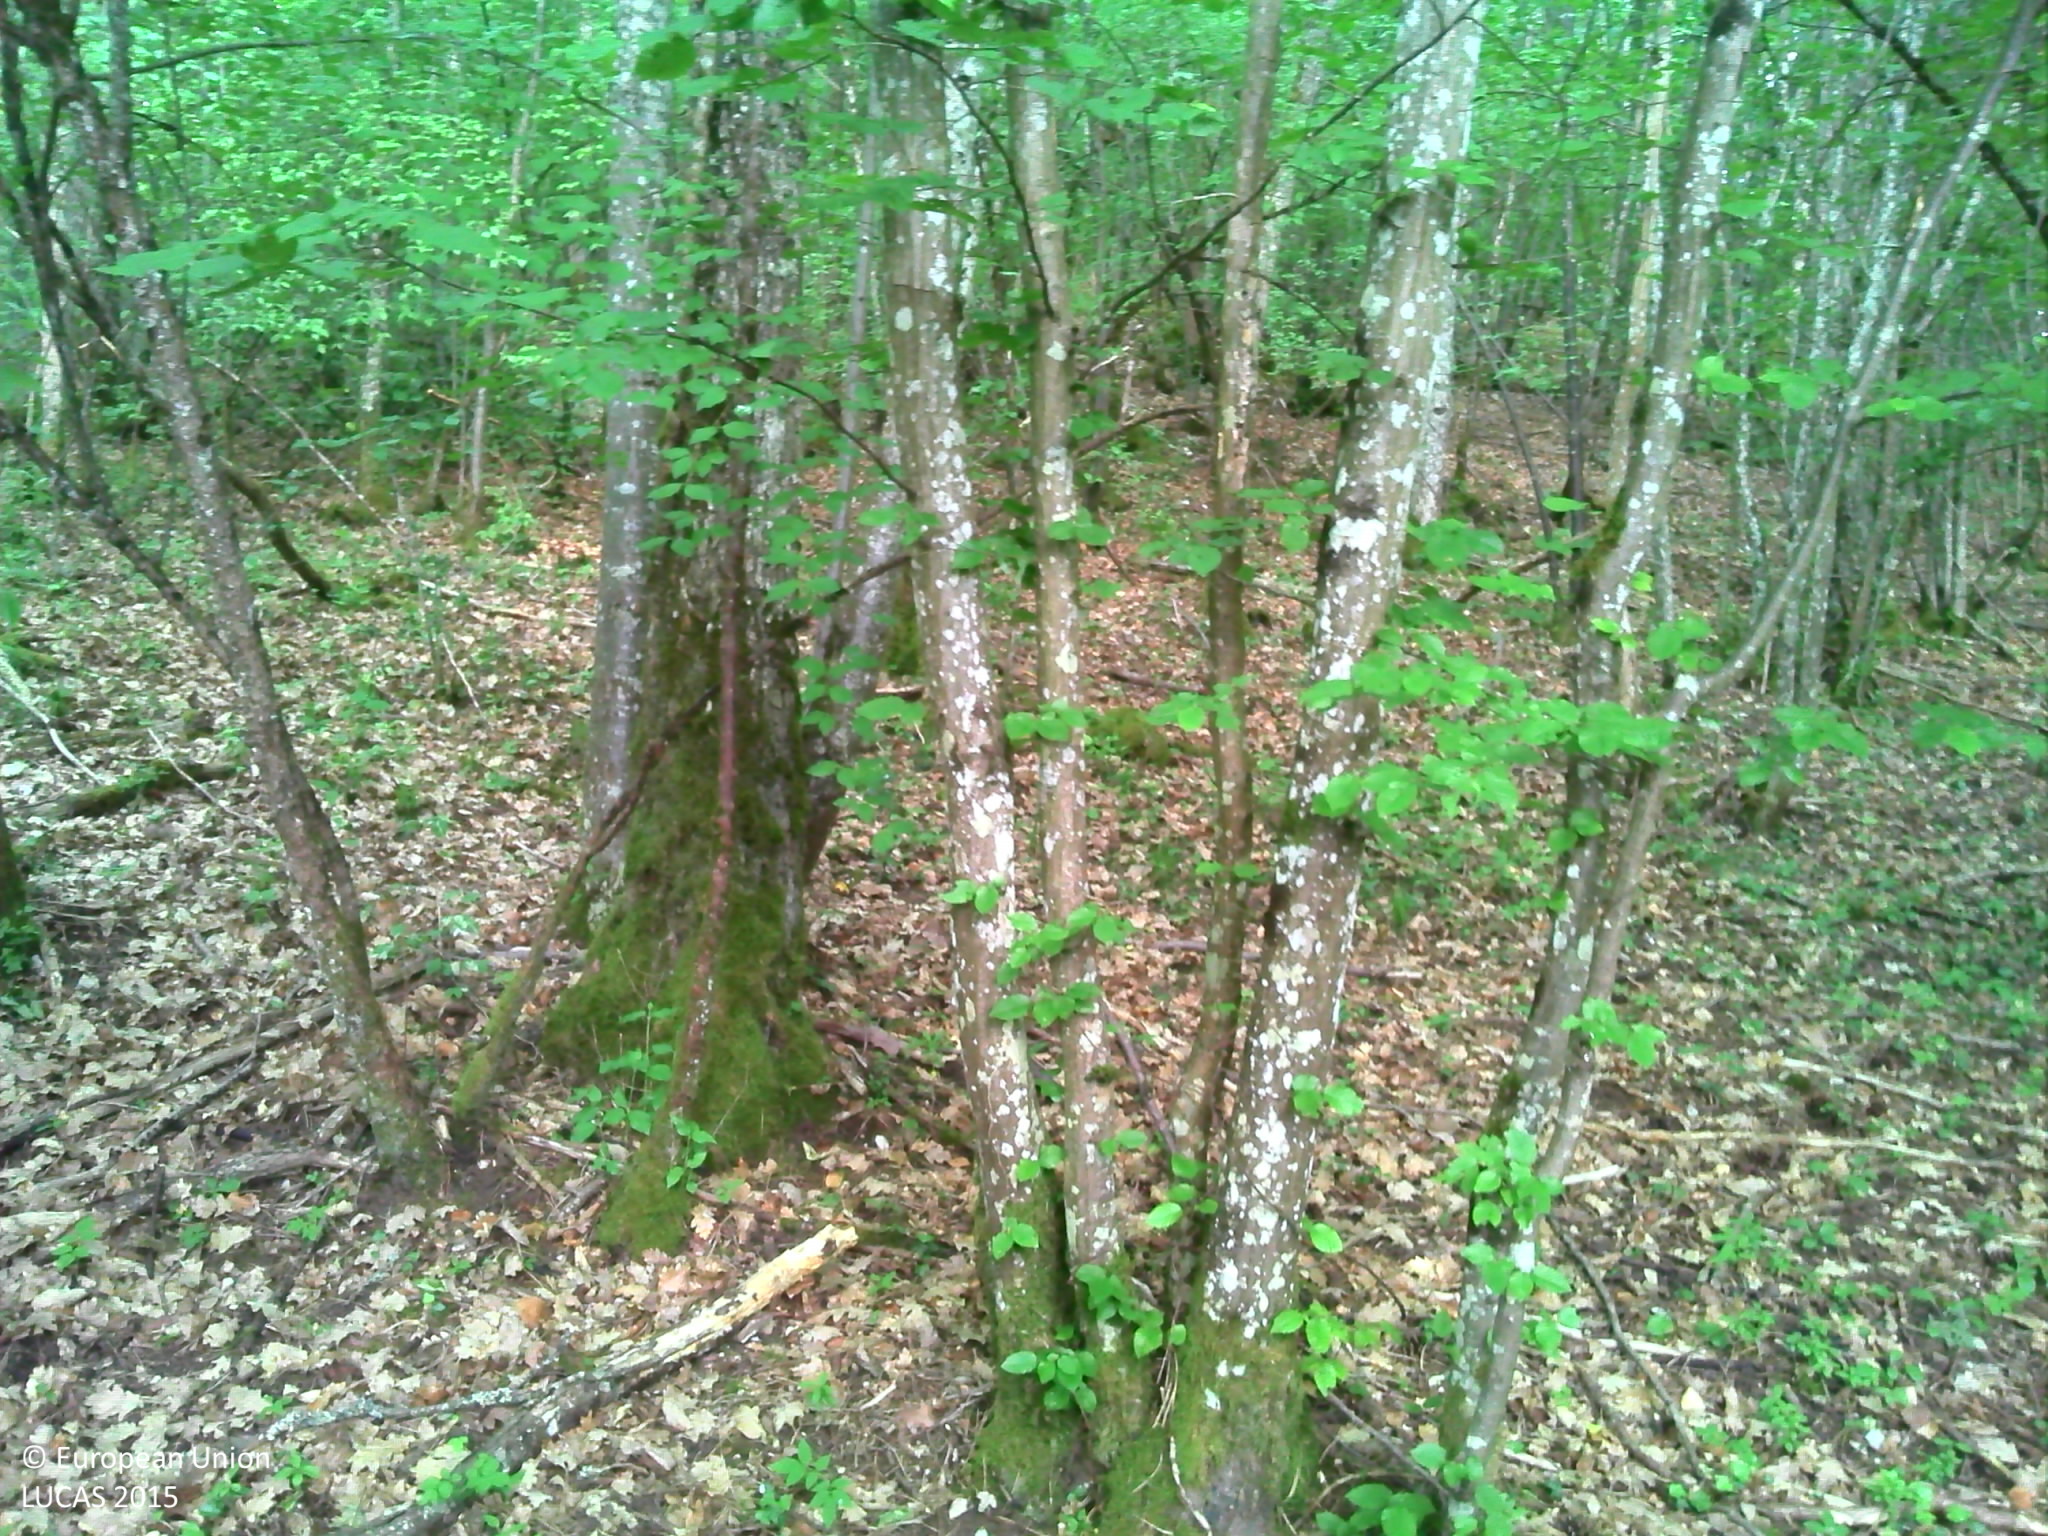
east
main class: Woodland
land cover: Pine dominated mixed woodland
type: mesophytic deciduous forest
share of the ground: > 75 %
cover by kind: broadleaved forest trees 55 %, coniferous forest trees 25 %, herbaceous plants 15 %, lichens and mosses 5 %
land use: Forestry
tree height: > 5 m
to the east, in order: Pine dominated mixed woodland; Tracks; Electric lines; Fences; Pine dominated mixed woodland; Fences; Grassland without tree/shrub cover
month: May
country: FR
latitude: 47.3137
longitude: 4.9338
